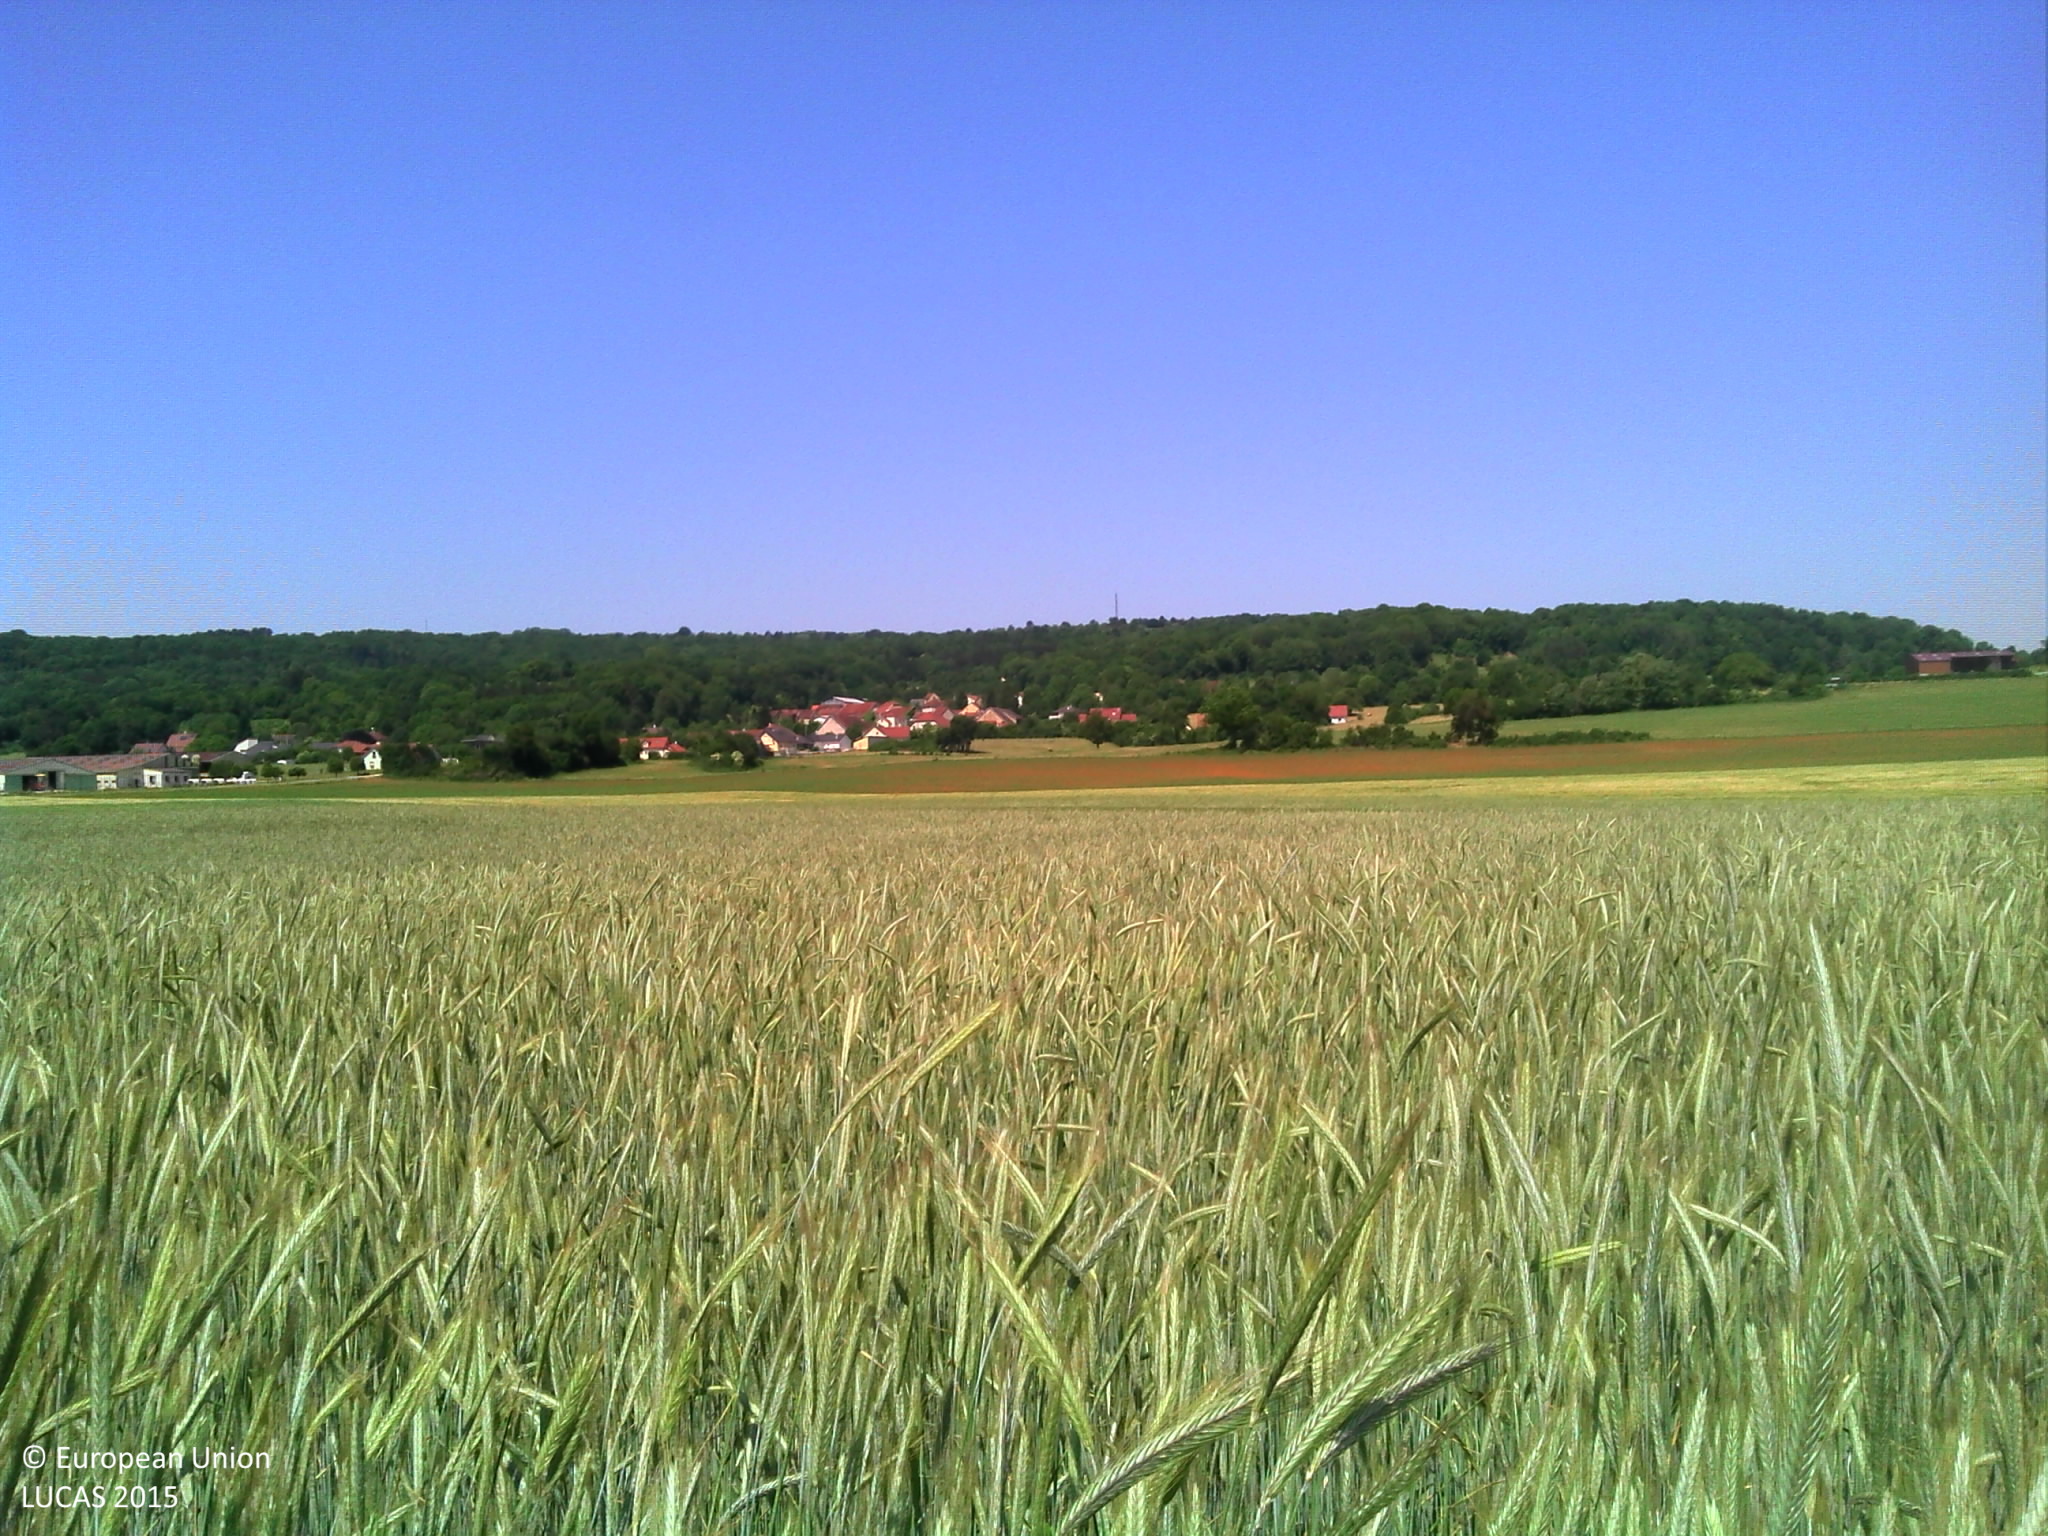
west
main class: Cropland
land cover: Rye
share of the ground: > 75 %
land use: Agriculture (excluding fallow land and kitchen gardens)
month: June
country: FR
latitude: 47.5810
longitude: 6.1855
